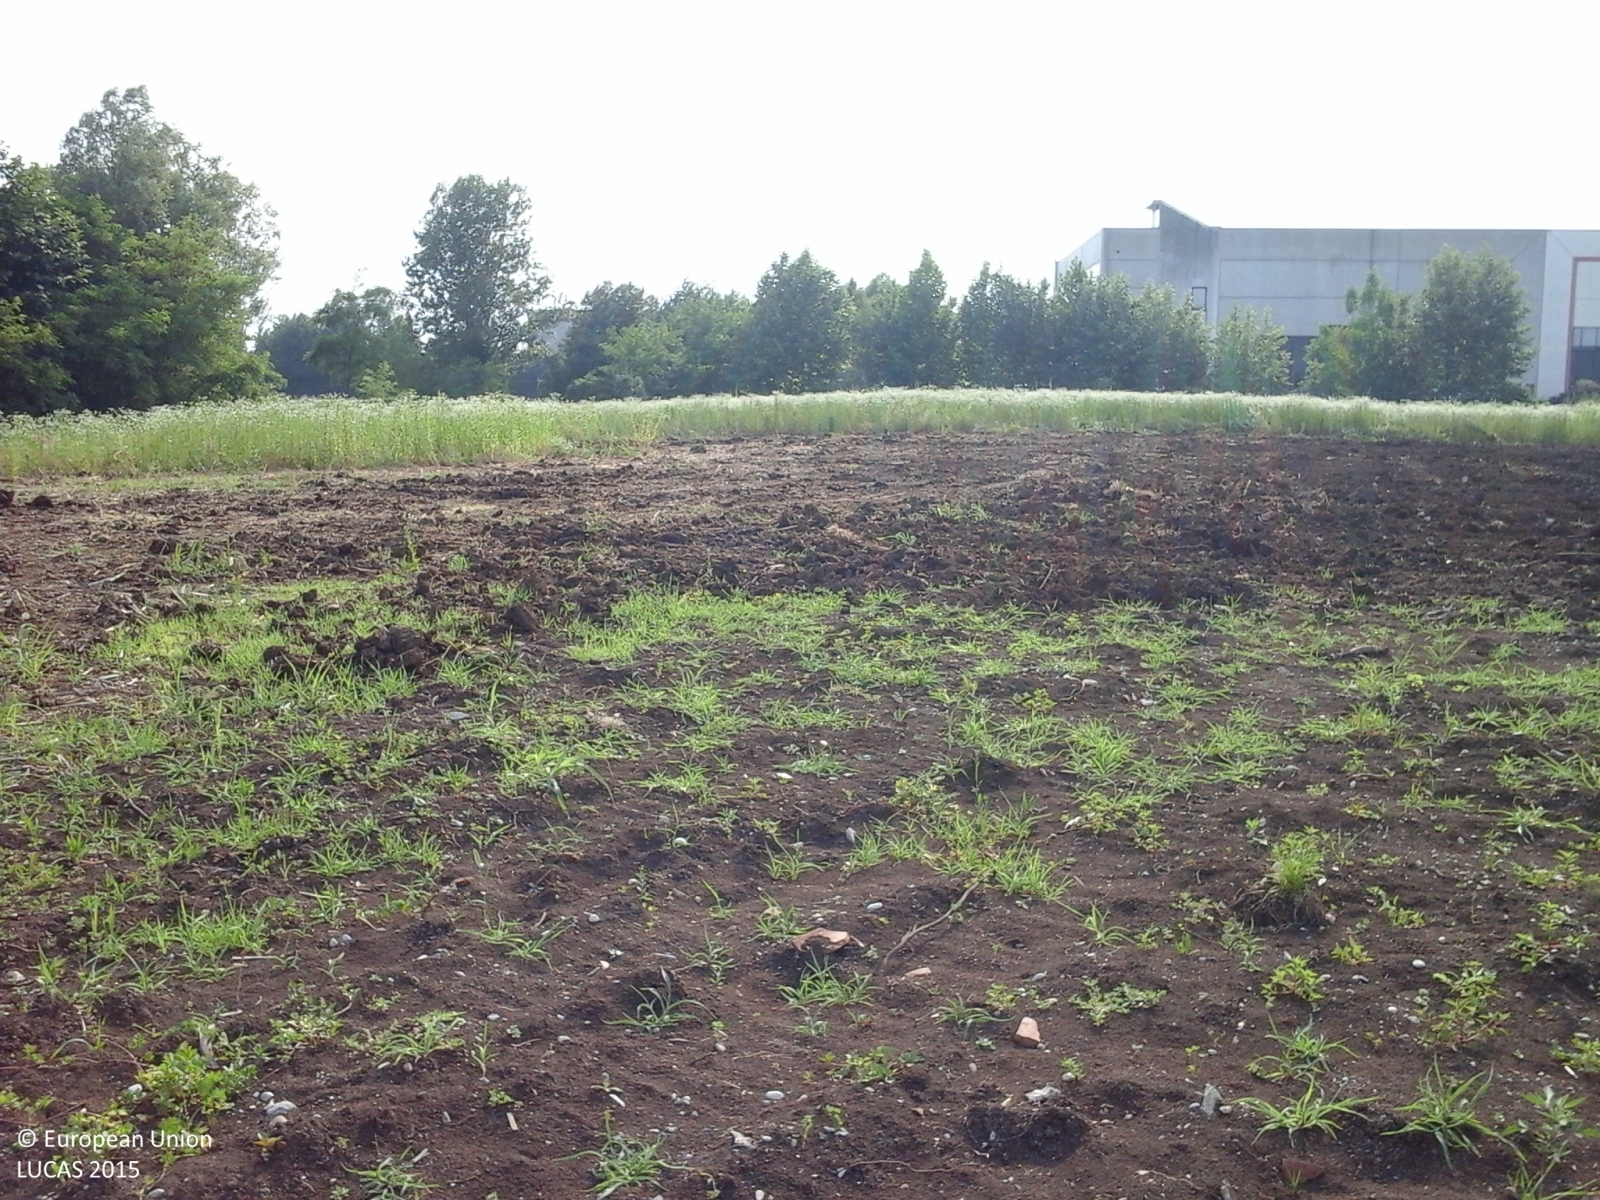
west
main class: Grassland
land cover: Spontaneously vegetated surfaces
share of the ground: 25 - 50 %
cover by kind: consolidated bare surface 60 %, herbaceous plants 40 %
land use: Fallow land
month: June
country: IT
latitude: 45.7261
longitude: 11.6294
